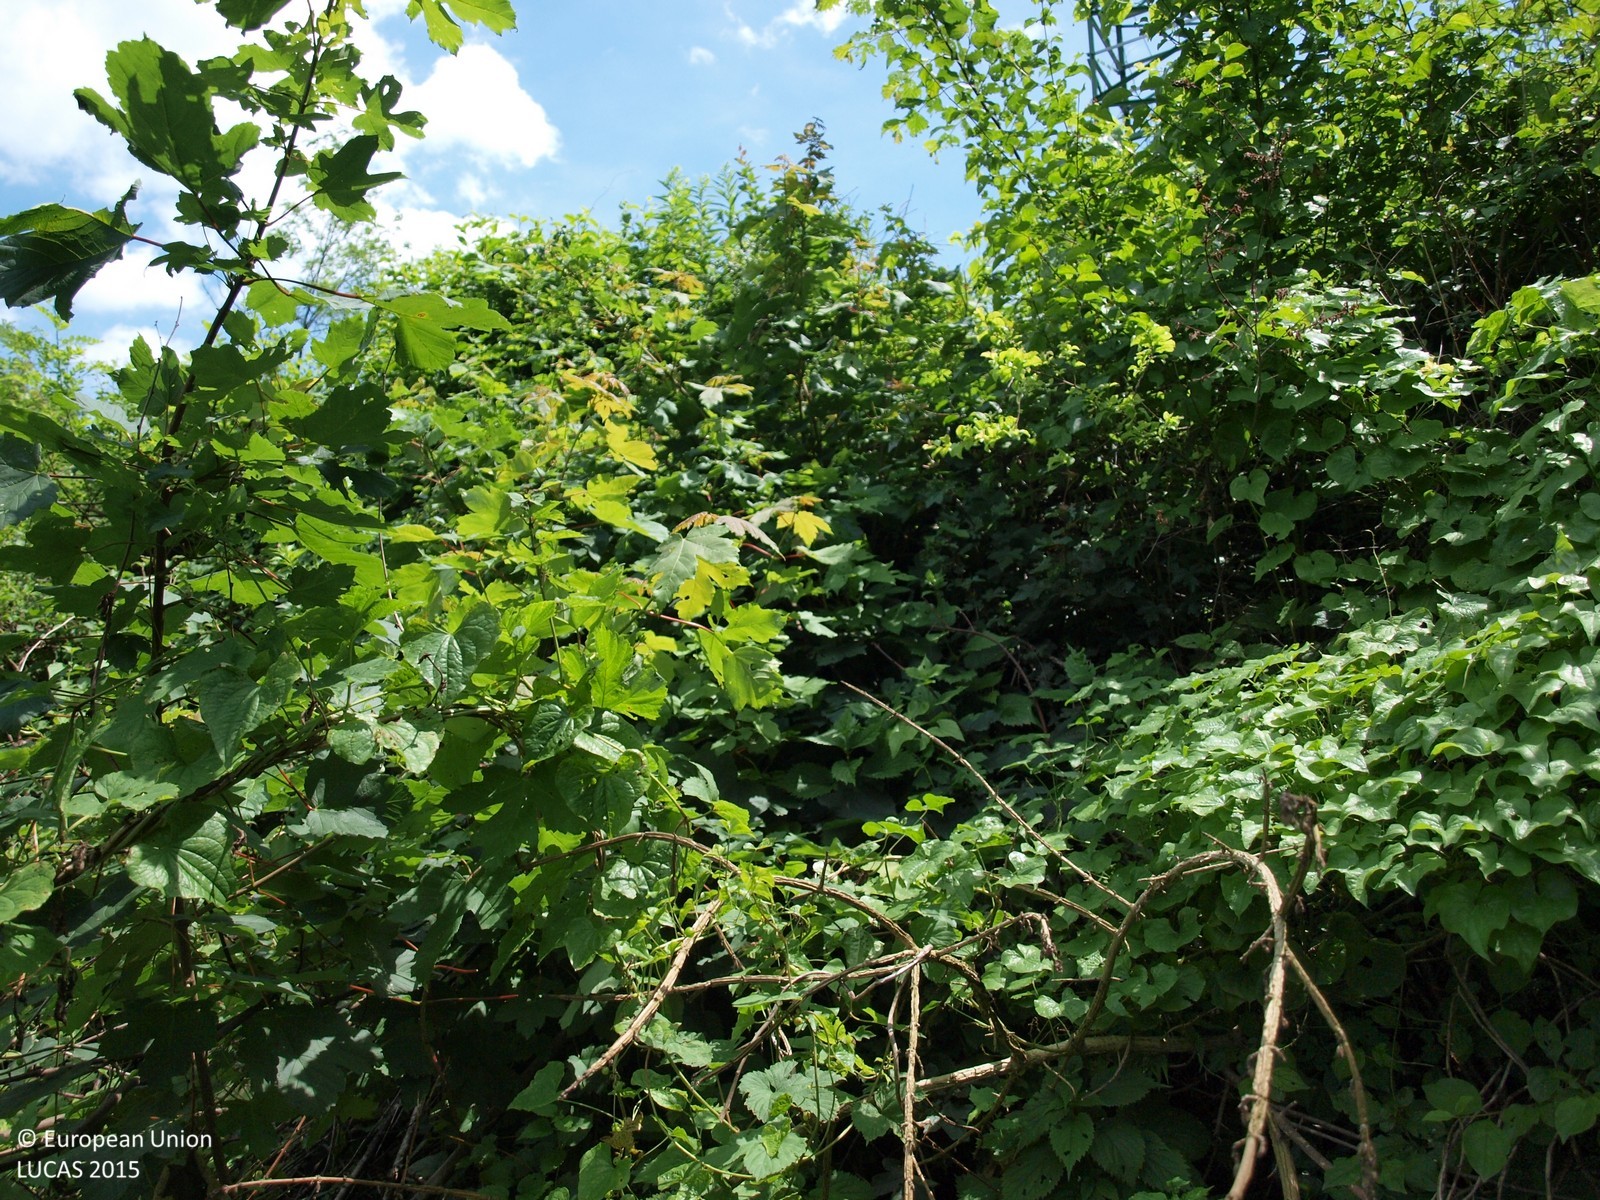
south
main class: Artificial land
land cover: Other artificial areas
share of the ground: 25 - 50 %
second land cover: Shrubland without tree cover
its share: > 75 %
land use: Electricity, gas and thermal power distribution
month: June
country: HR
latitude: 46.1253
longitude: 15.7314
